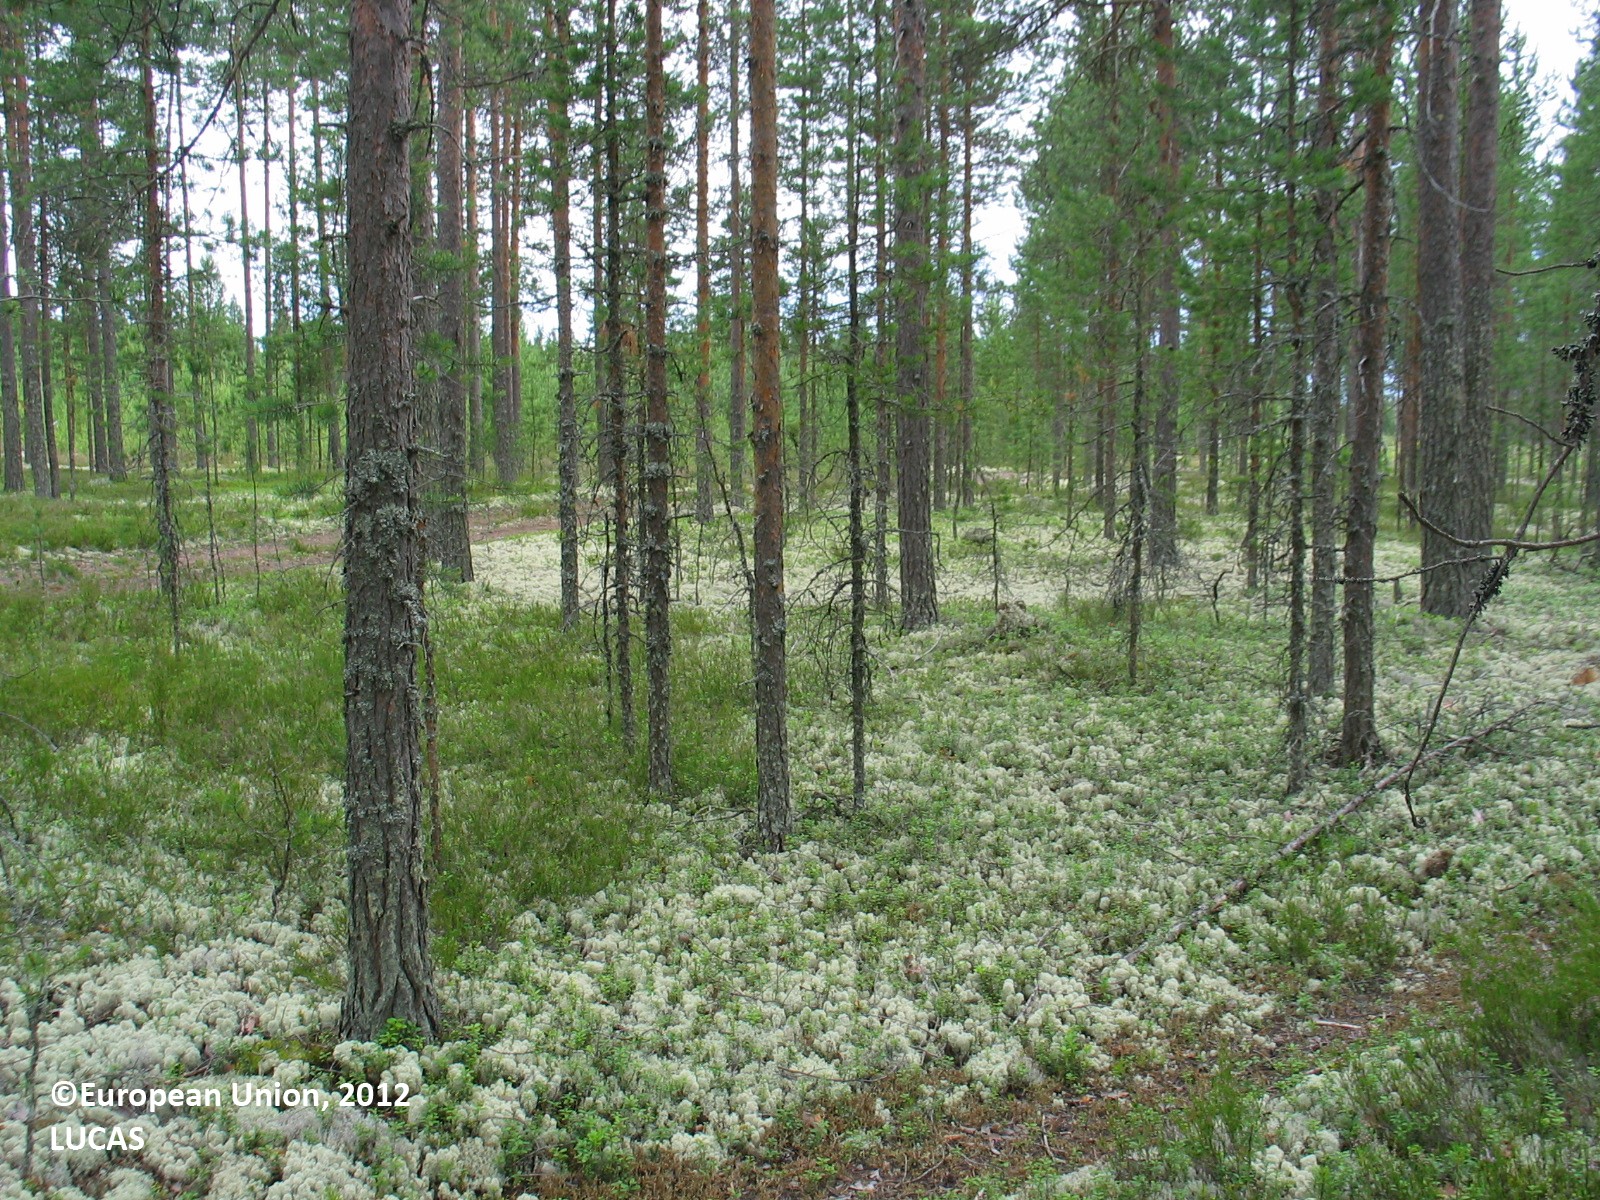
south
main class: Woodland
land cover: Pine dominated coniferous woodland
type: boreal forest
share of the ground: 50 - 75 %
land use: Forestry
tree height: > 5 m
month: July
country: FI
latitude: 64.6336
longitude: 26.3646
